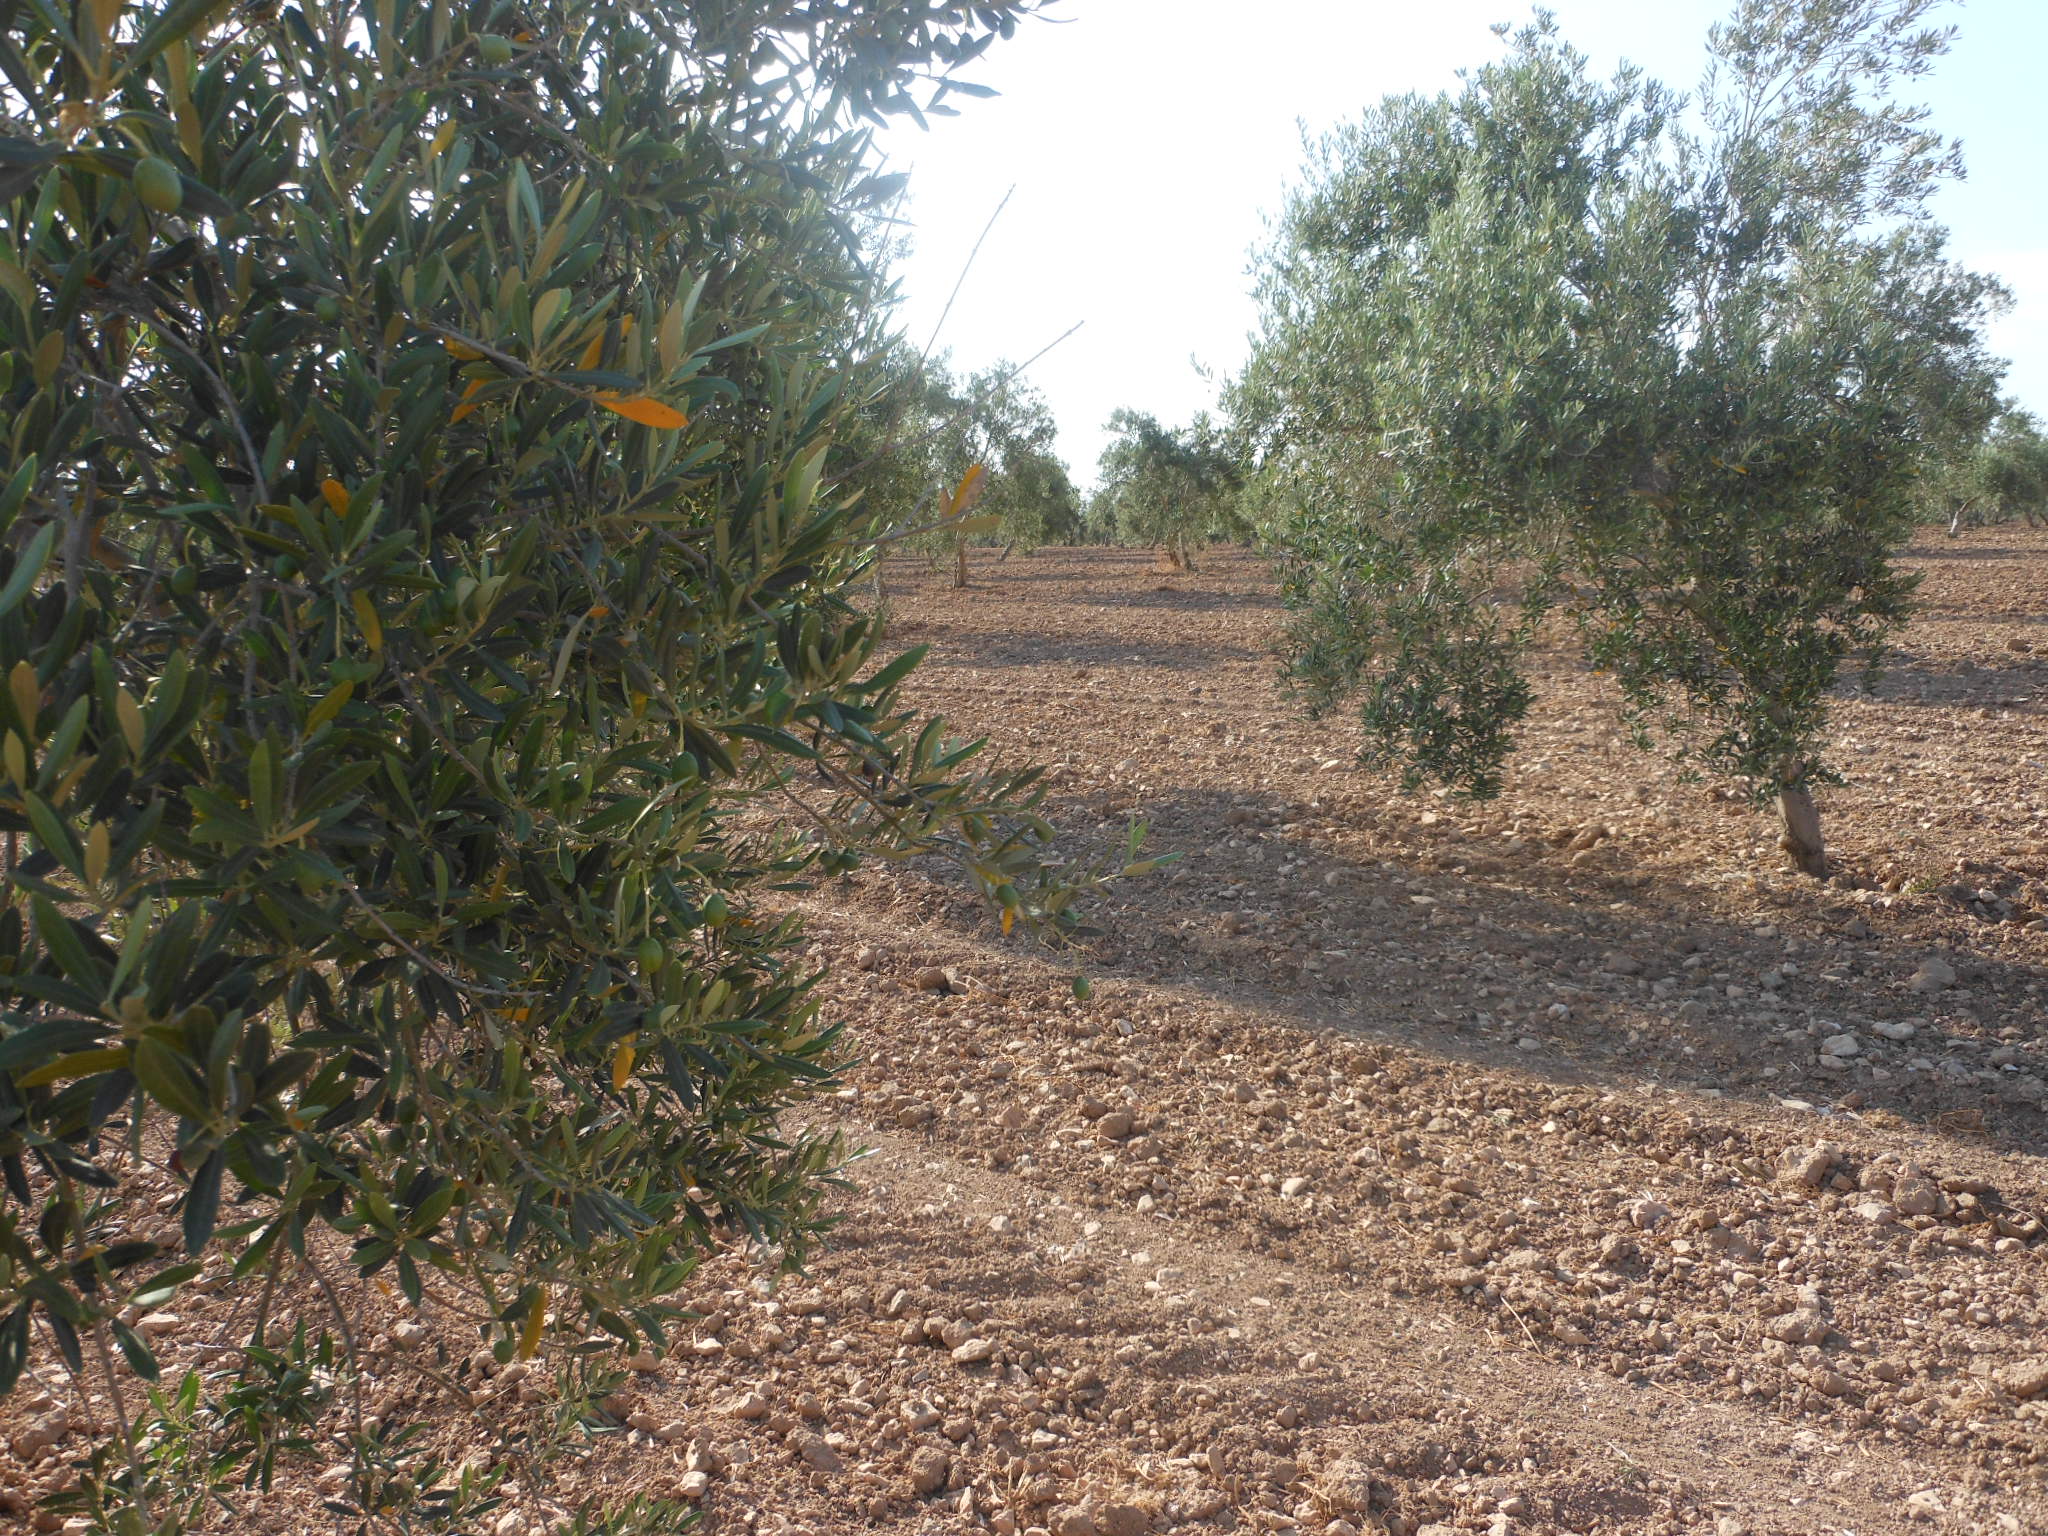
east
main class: Cropland
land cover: Olive groves
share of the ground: 10 - 25 %
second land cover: Other bare soil
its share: > 75 %
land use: Agriculture (excluding fallow land and kitchen gardens)
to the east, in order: Olive groves; Other bare soil
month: June
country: ES
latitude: 37.2871
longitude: -5.1119
